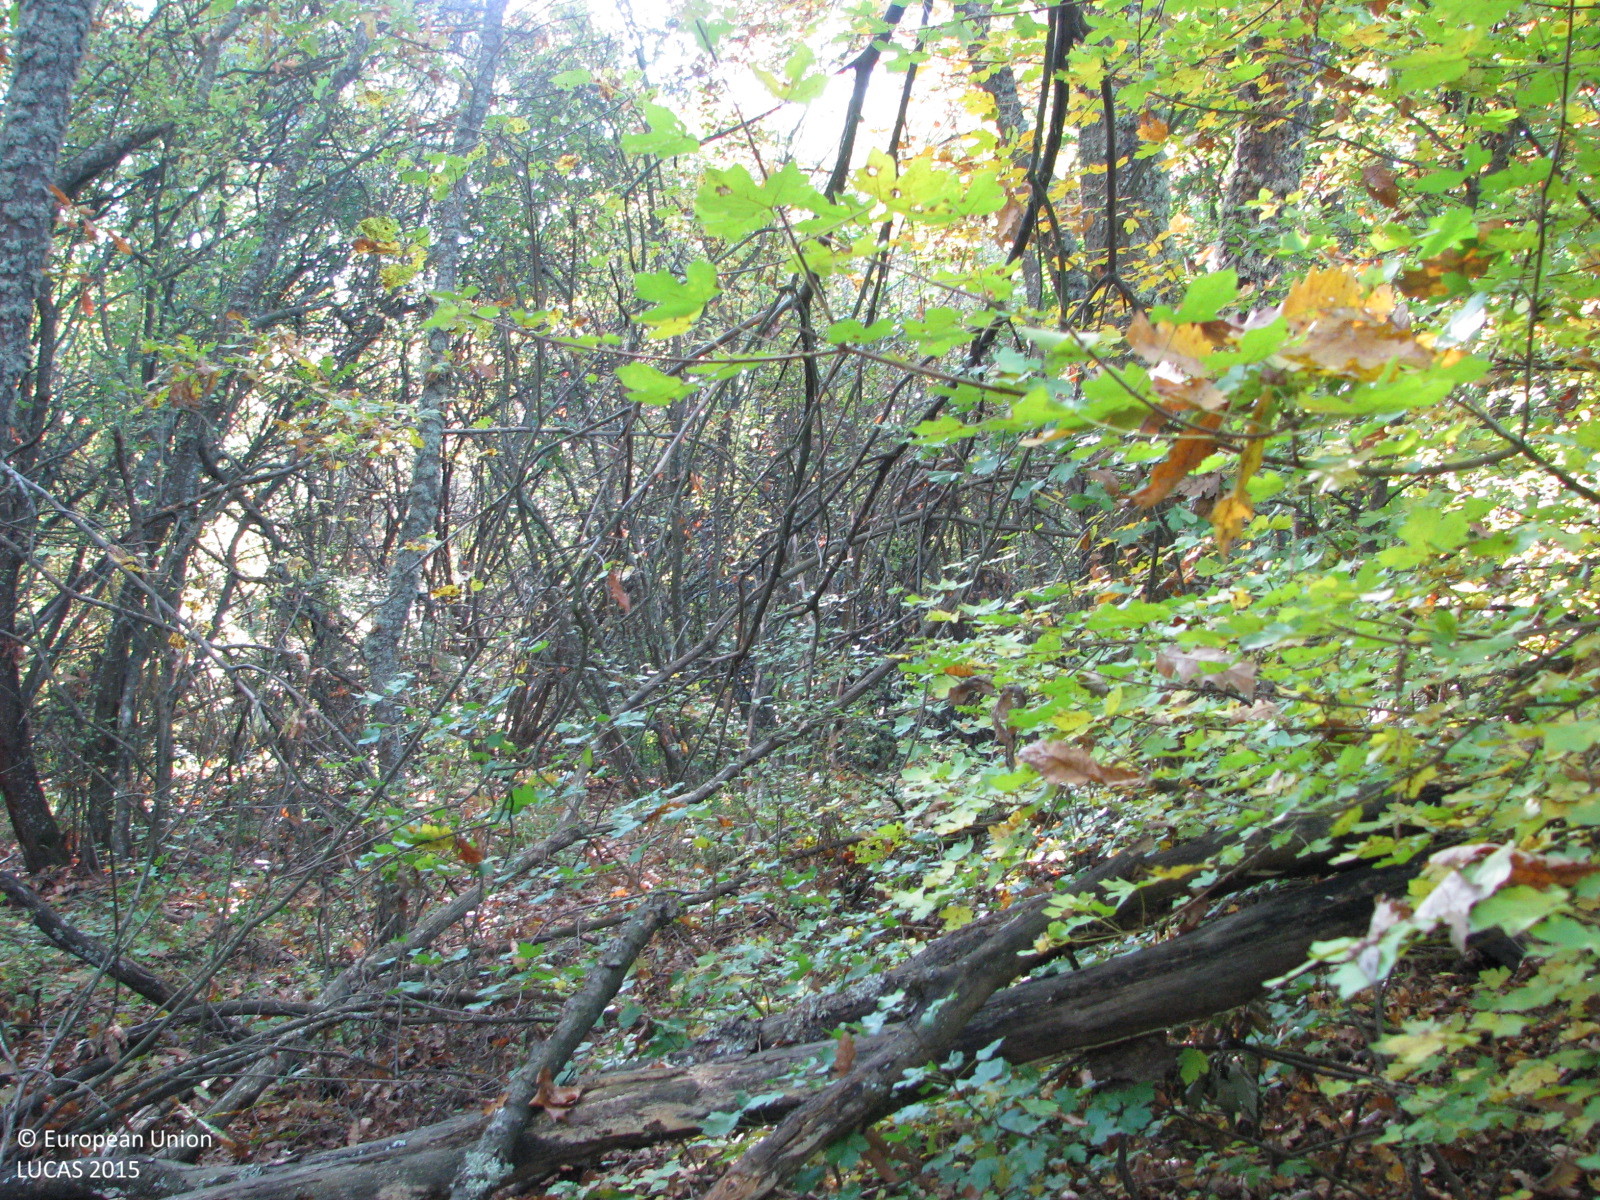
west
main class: Woodland
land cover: Broadleaved woodland
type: thermophilous deciduous forest
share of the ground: 50 - 75 %
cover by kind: broadleaved forest trees 70 %, unconsolidated bare surface 20 %, shrubs 10 %
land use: Forestry
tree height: > 5 m
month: October
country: BG
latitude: 42.3469
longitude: 26.8879
